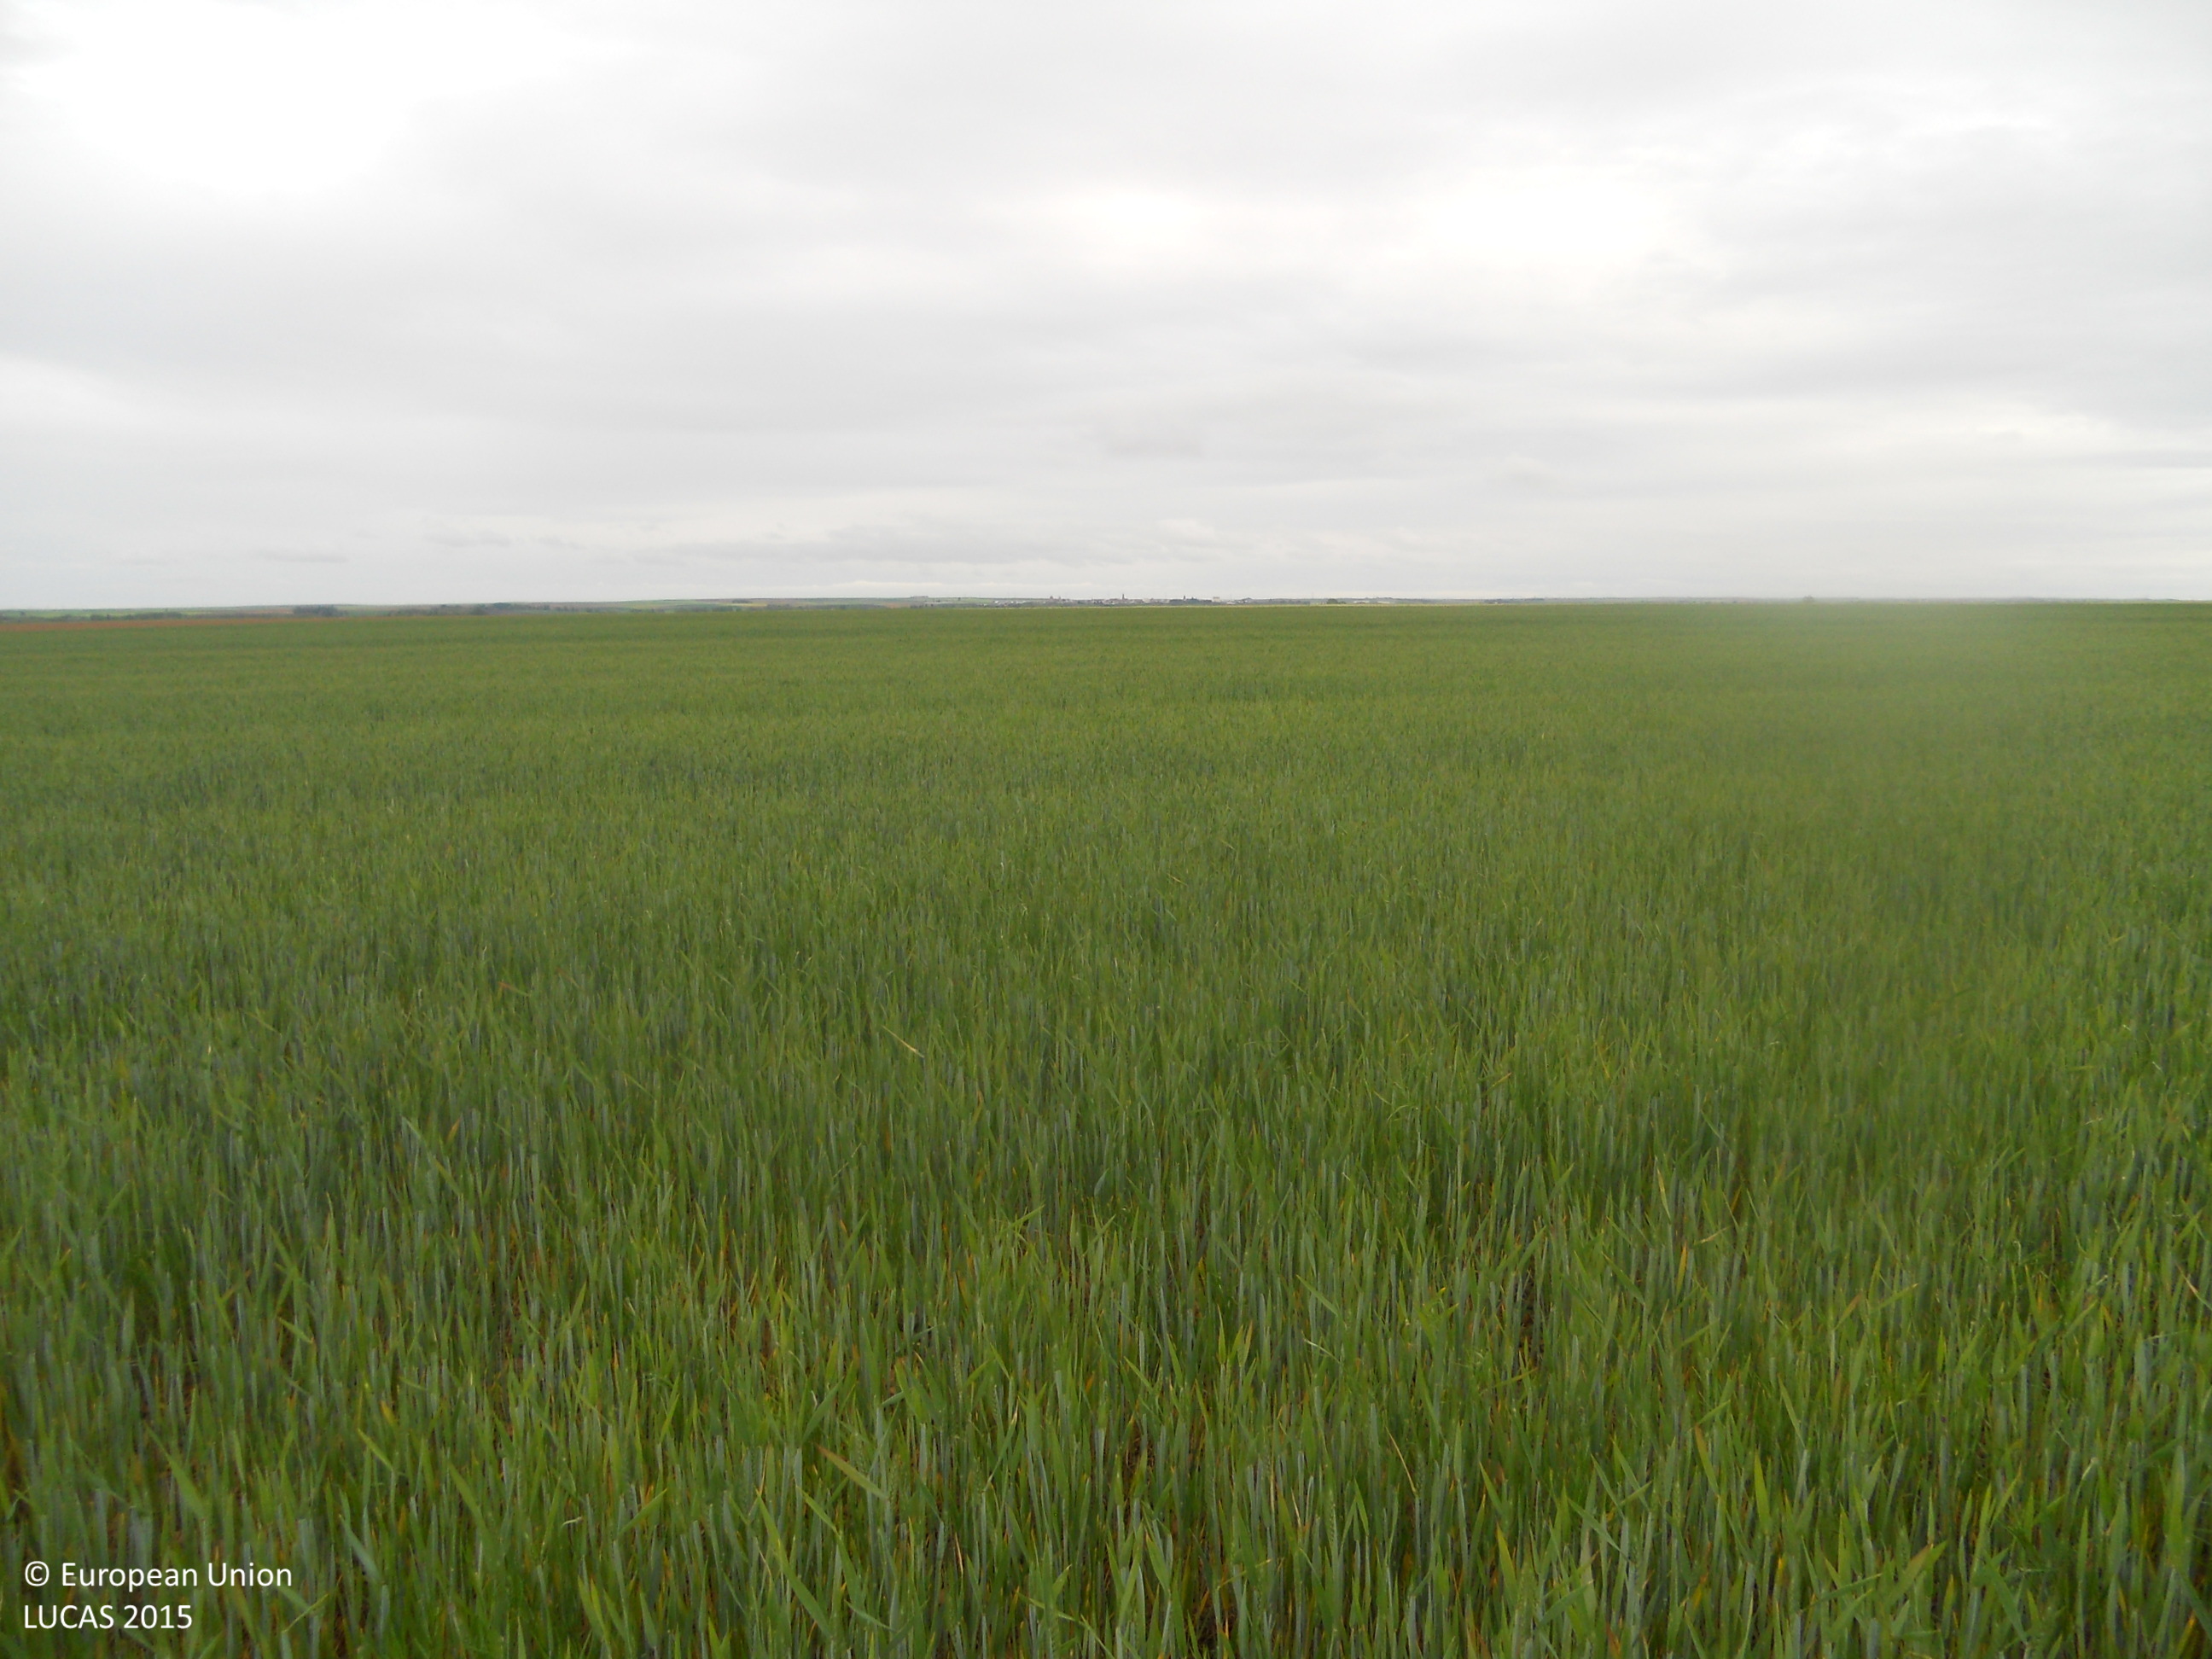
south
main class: Cropland
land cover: Common wheat
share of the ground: > 75 %
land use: Agriculture (excluding fallow land and kitchen gardens)
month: May
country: ES
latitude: 42.2227
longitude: -5.2666
